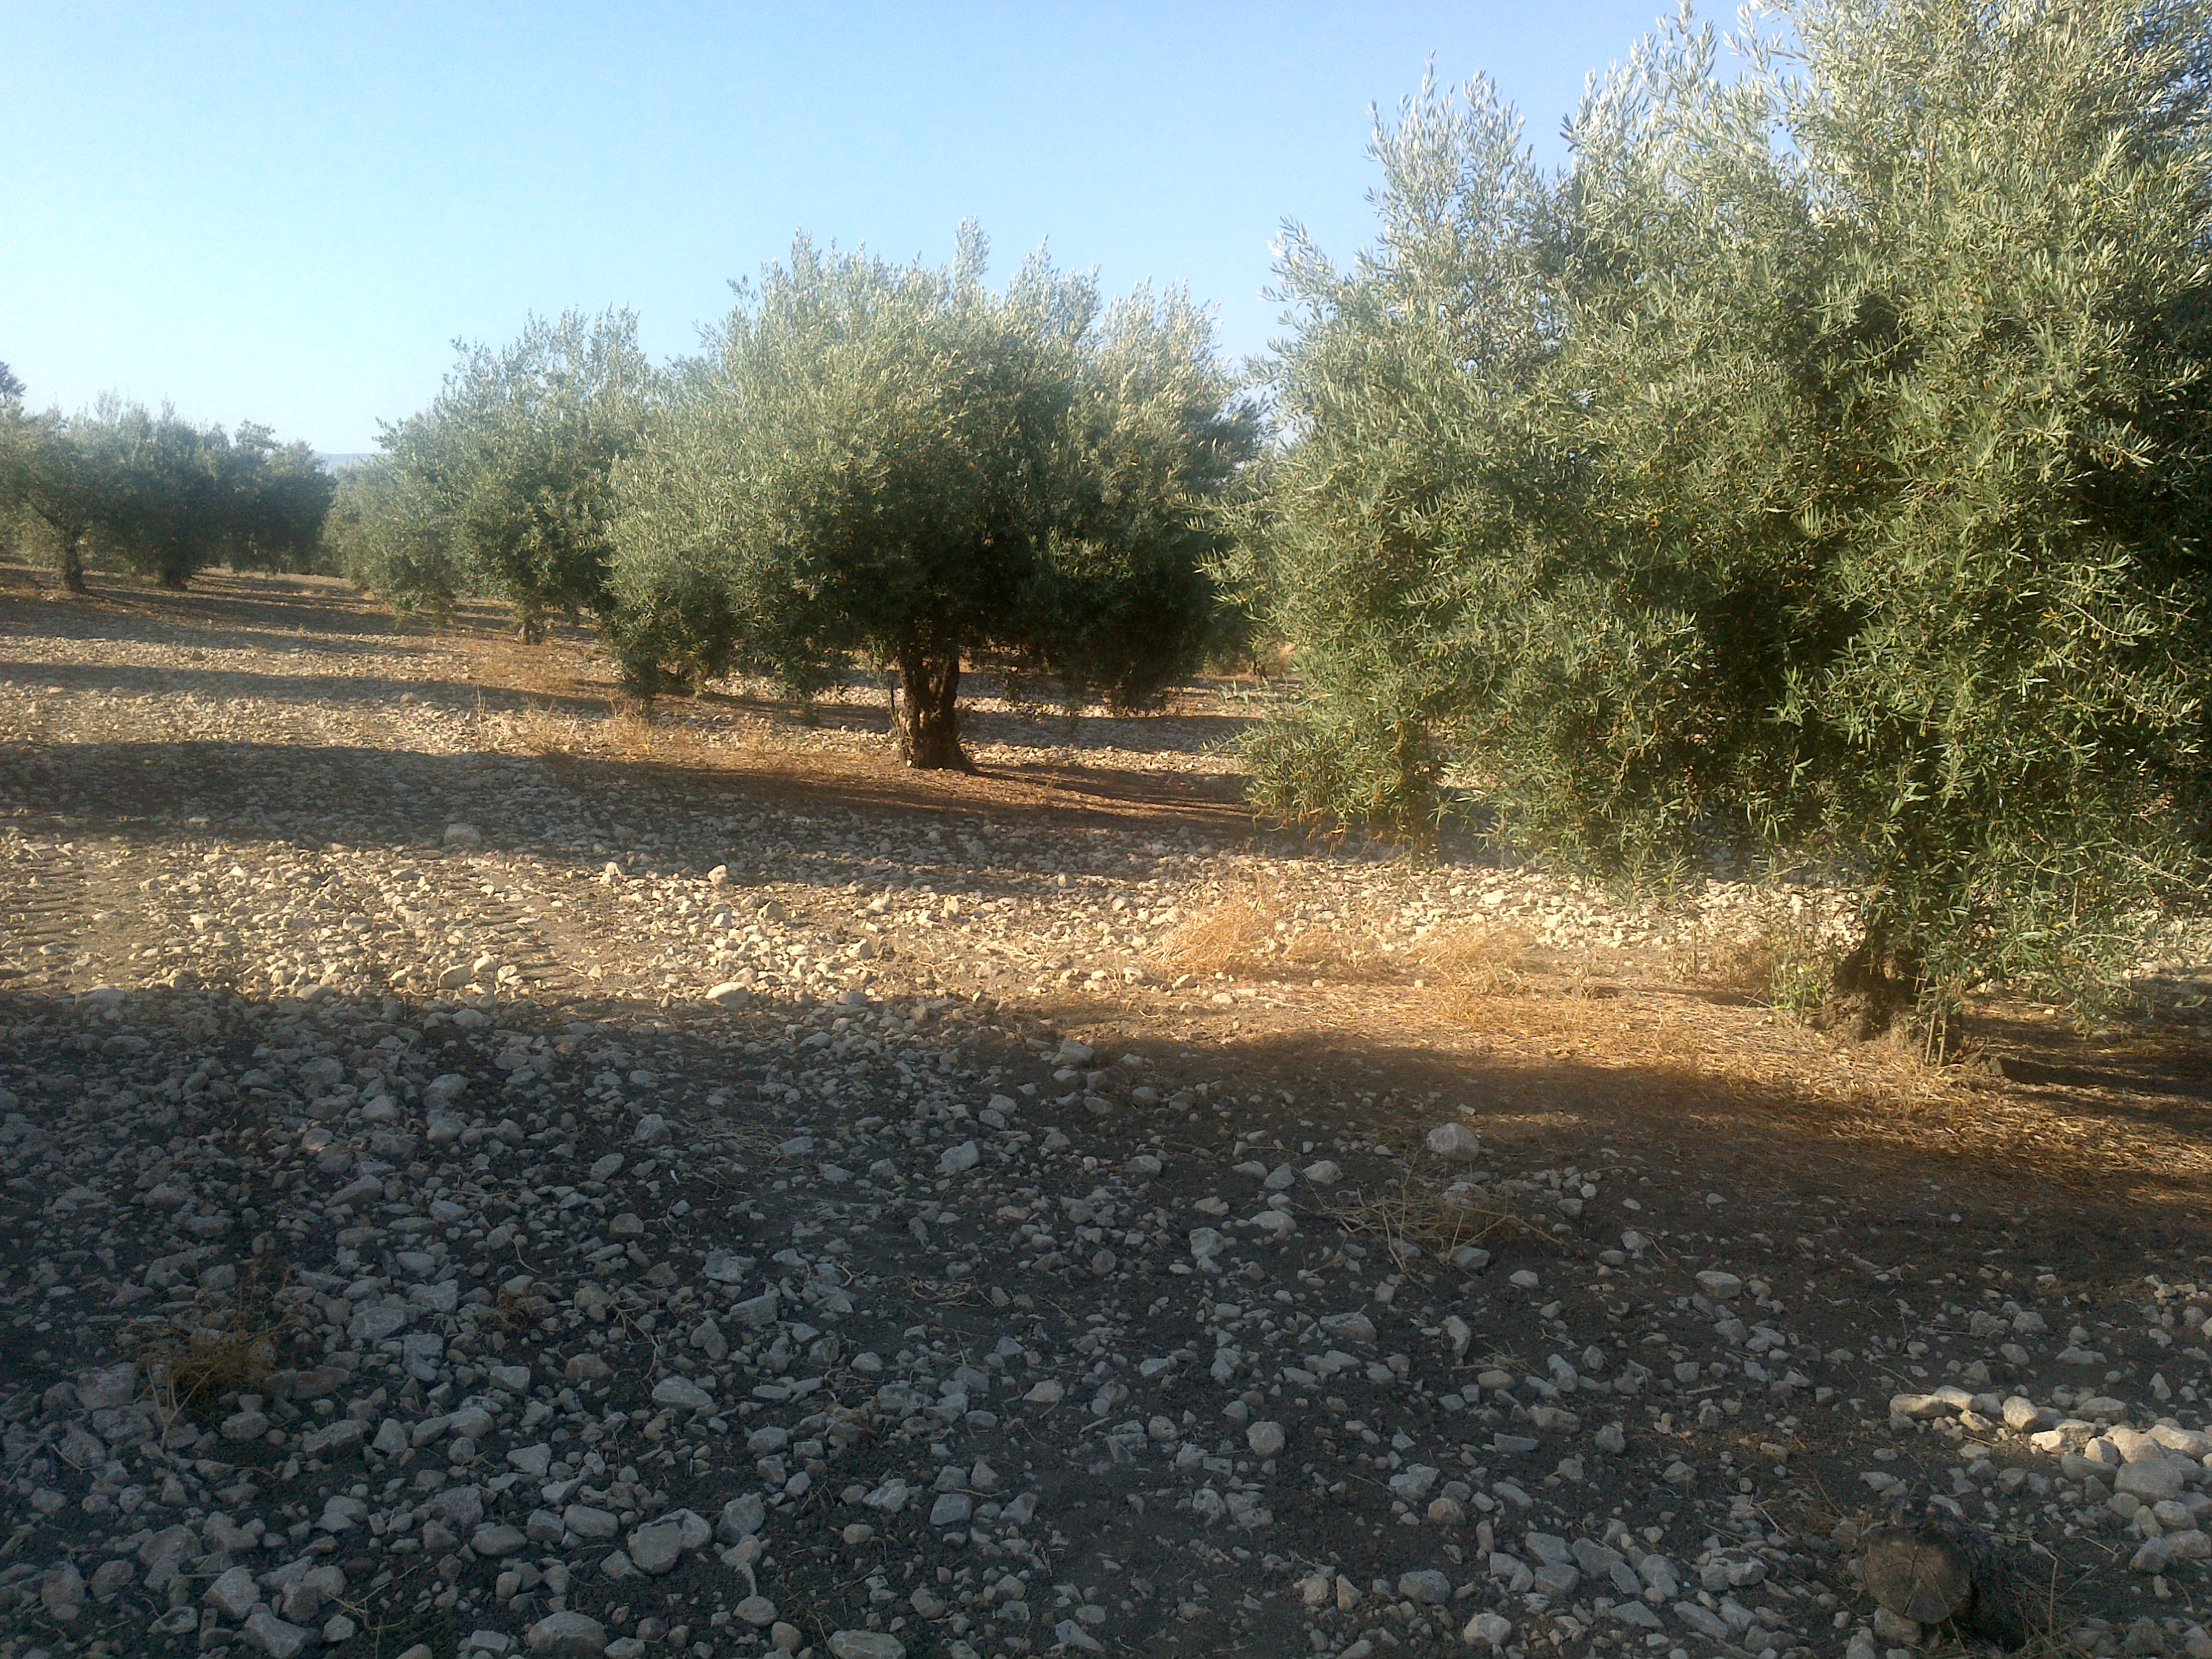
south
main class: Cropland
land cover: Olive groves
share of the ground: 50 - 75 %
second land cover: Other bare soil
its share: > 75 %
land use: Agriculture (excluding fallow land and kitchen gardens)
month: June
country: ES
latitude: 37.6901
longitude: -4.4201
